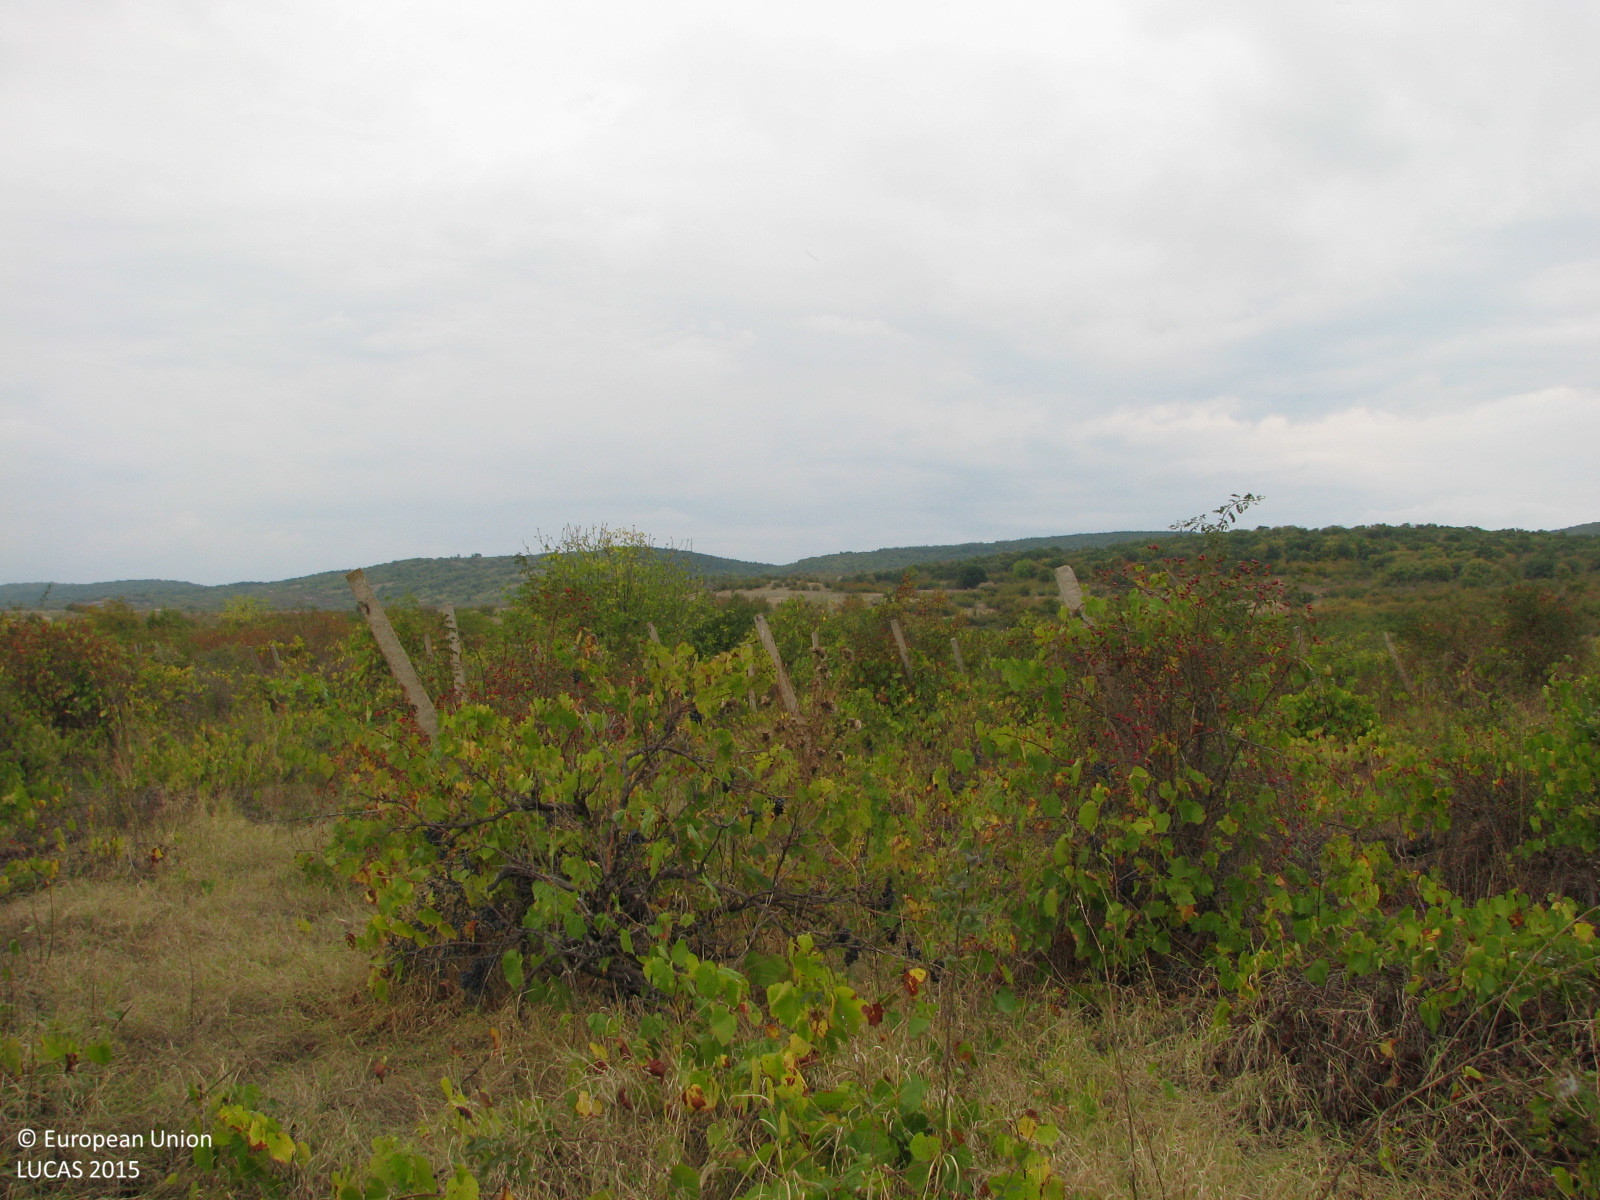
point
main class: Cropland
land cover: Vineyards
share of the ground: > 75 %
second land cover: Spontaneously vegetated surfaces
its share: 50 - 75 %
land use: Agriculture (excluding fallow land and kitchen gardens)
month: October
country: BG
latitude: 42.5685
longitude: 26.1031
